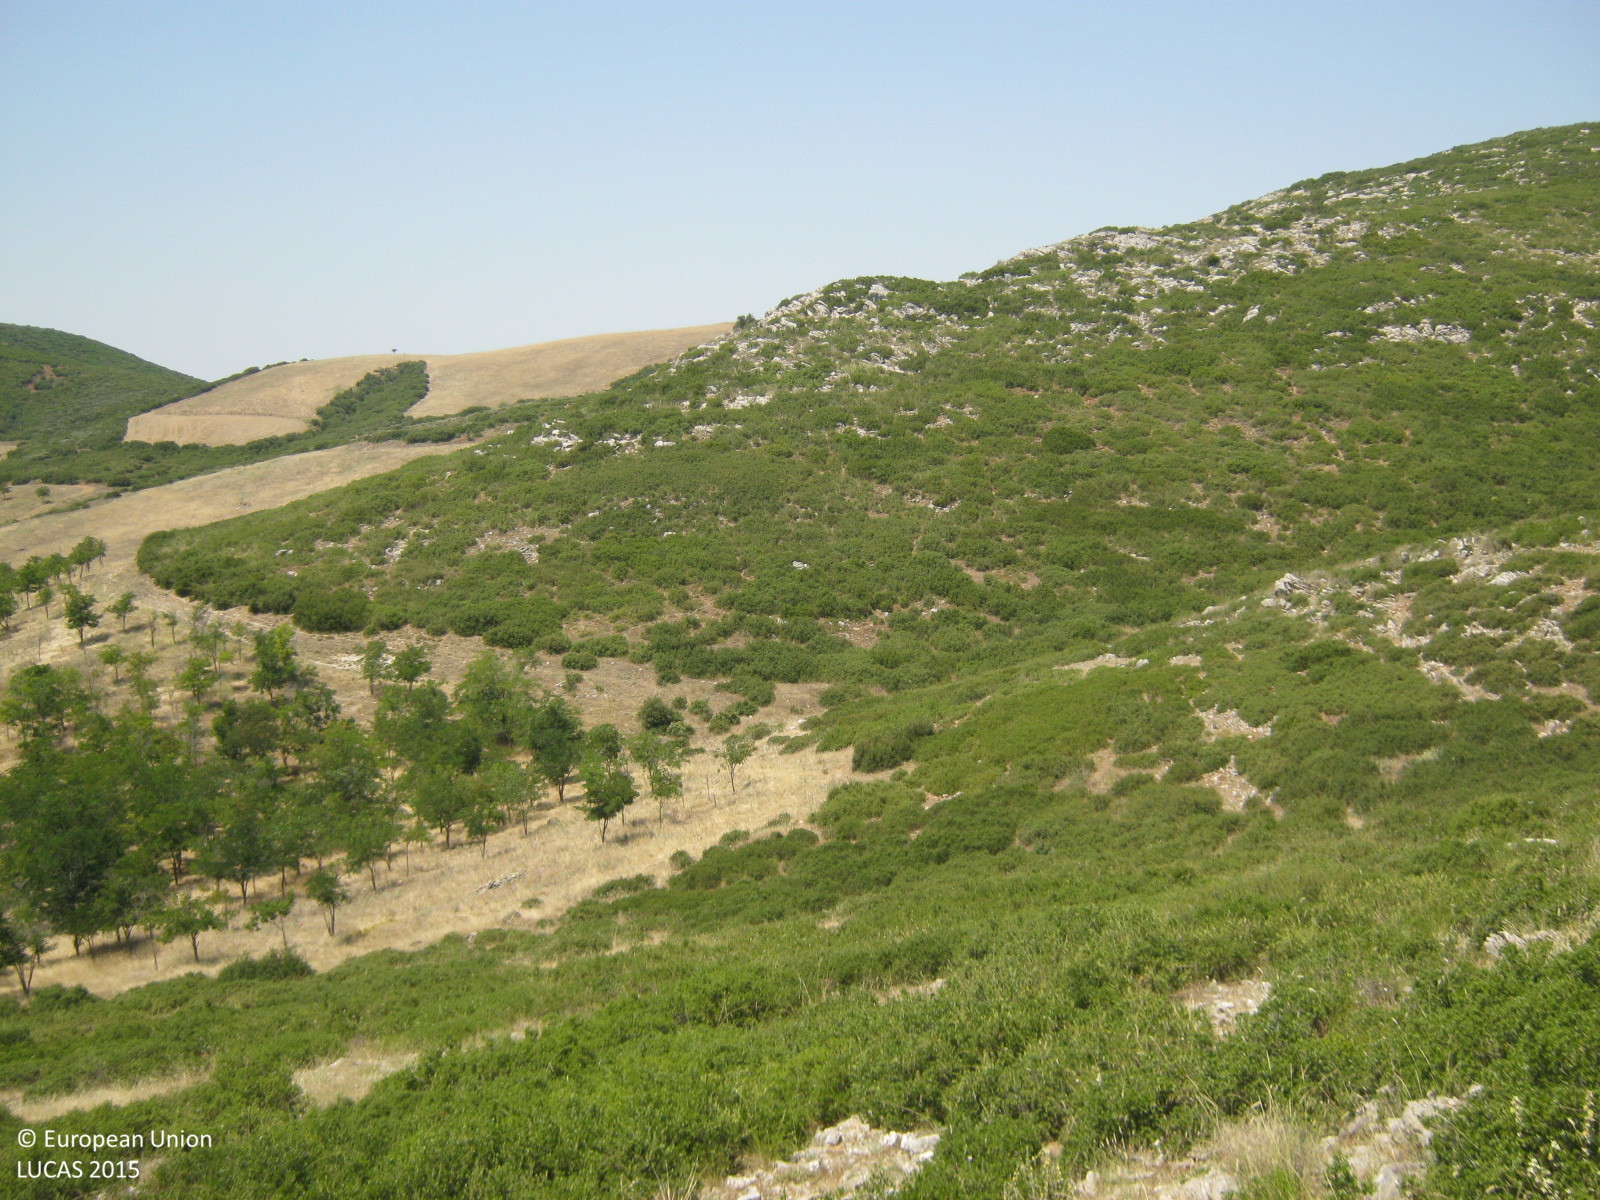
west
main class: Shrubland
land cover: Shrubland without tree cover
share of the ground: 50 - 75 %
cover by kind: shrubs 70 %, unconsolidated bare surface 20 %, herbaceous plants 10 %
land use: Abandoned areas
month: July
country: GR
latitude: 39.2971
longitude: 22.6615
